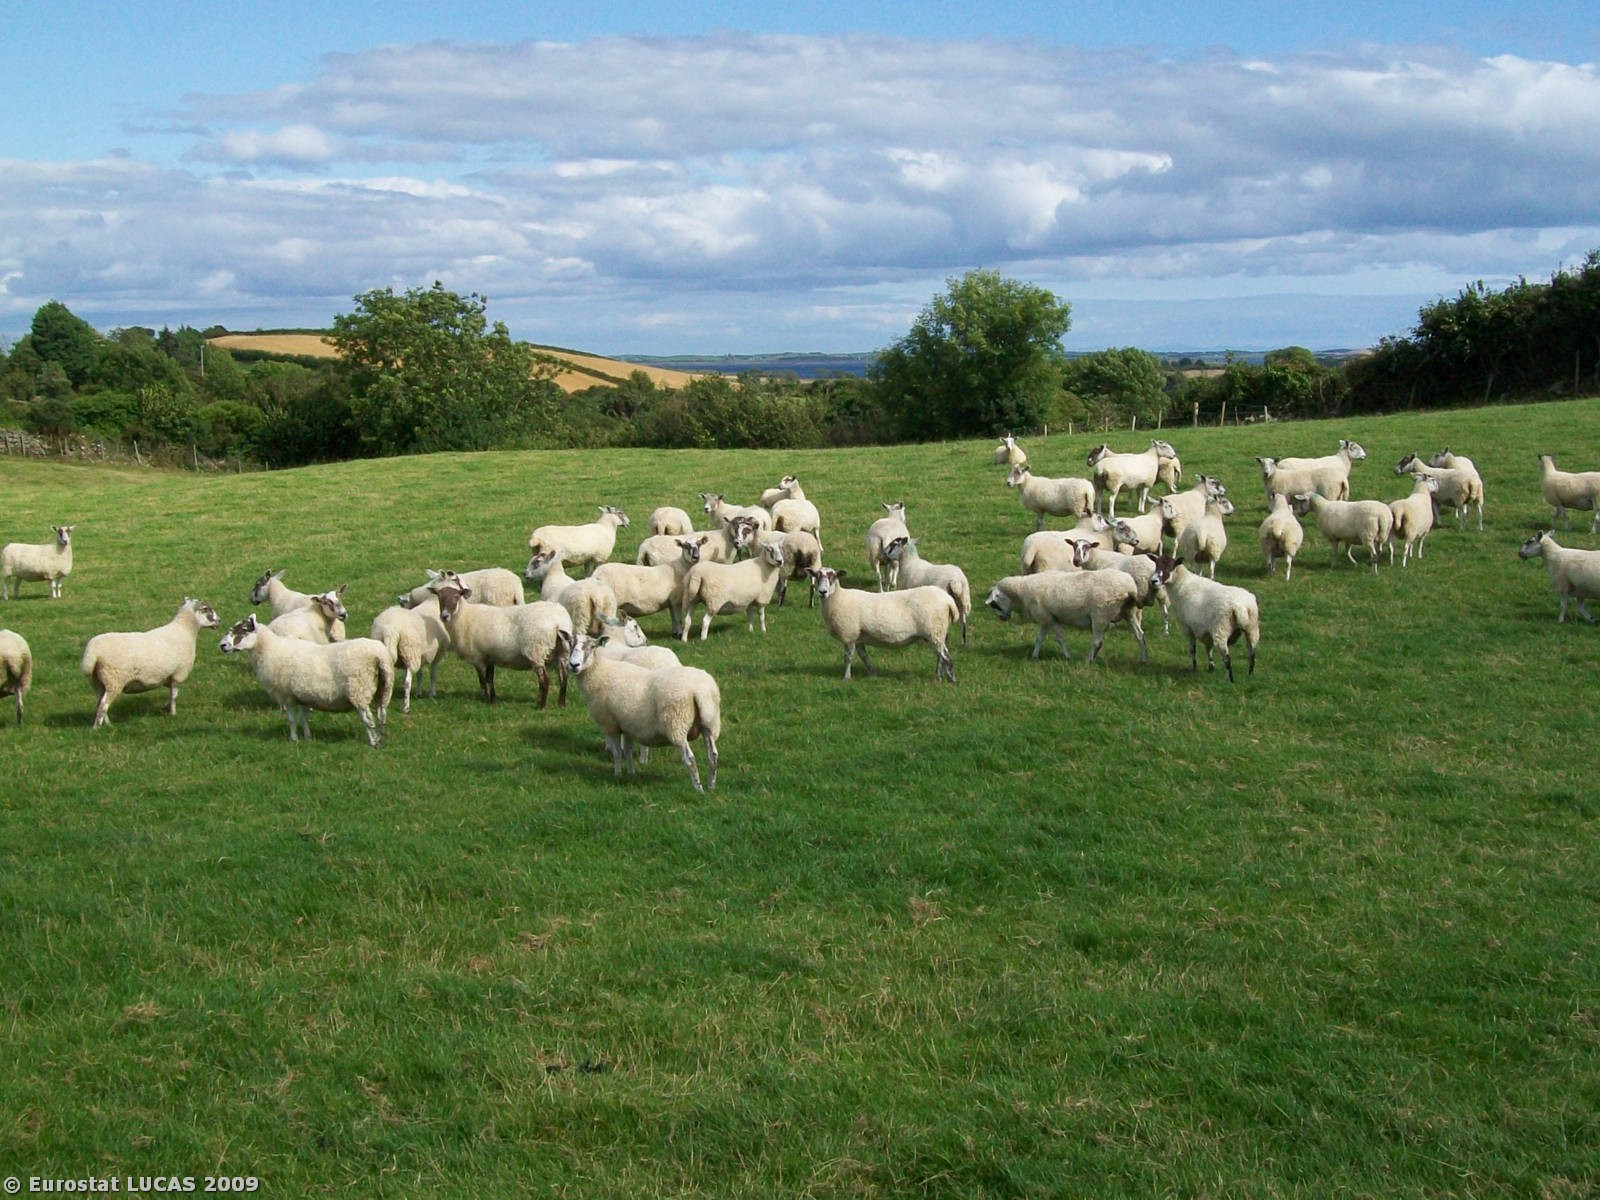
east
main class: Grassland
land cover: Grassland without tree/shrub cover
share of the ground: > 75 %
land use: Agriculture (excluding fallow land and kitchen gardens)
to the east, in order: Grassland without tree/shrub cover; Fences; Broadleaved woodland; Fences; Grassland with sparse tree/shrub cover; Fences; Dry stone walls; Grassland without tree/shrub cover; Inland water bodies; Grassland without tree/shrub cover
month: August
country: GB
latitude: 54.4639
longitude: -5.6677
